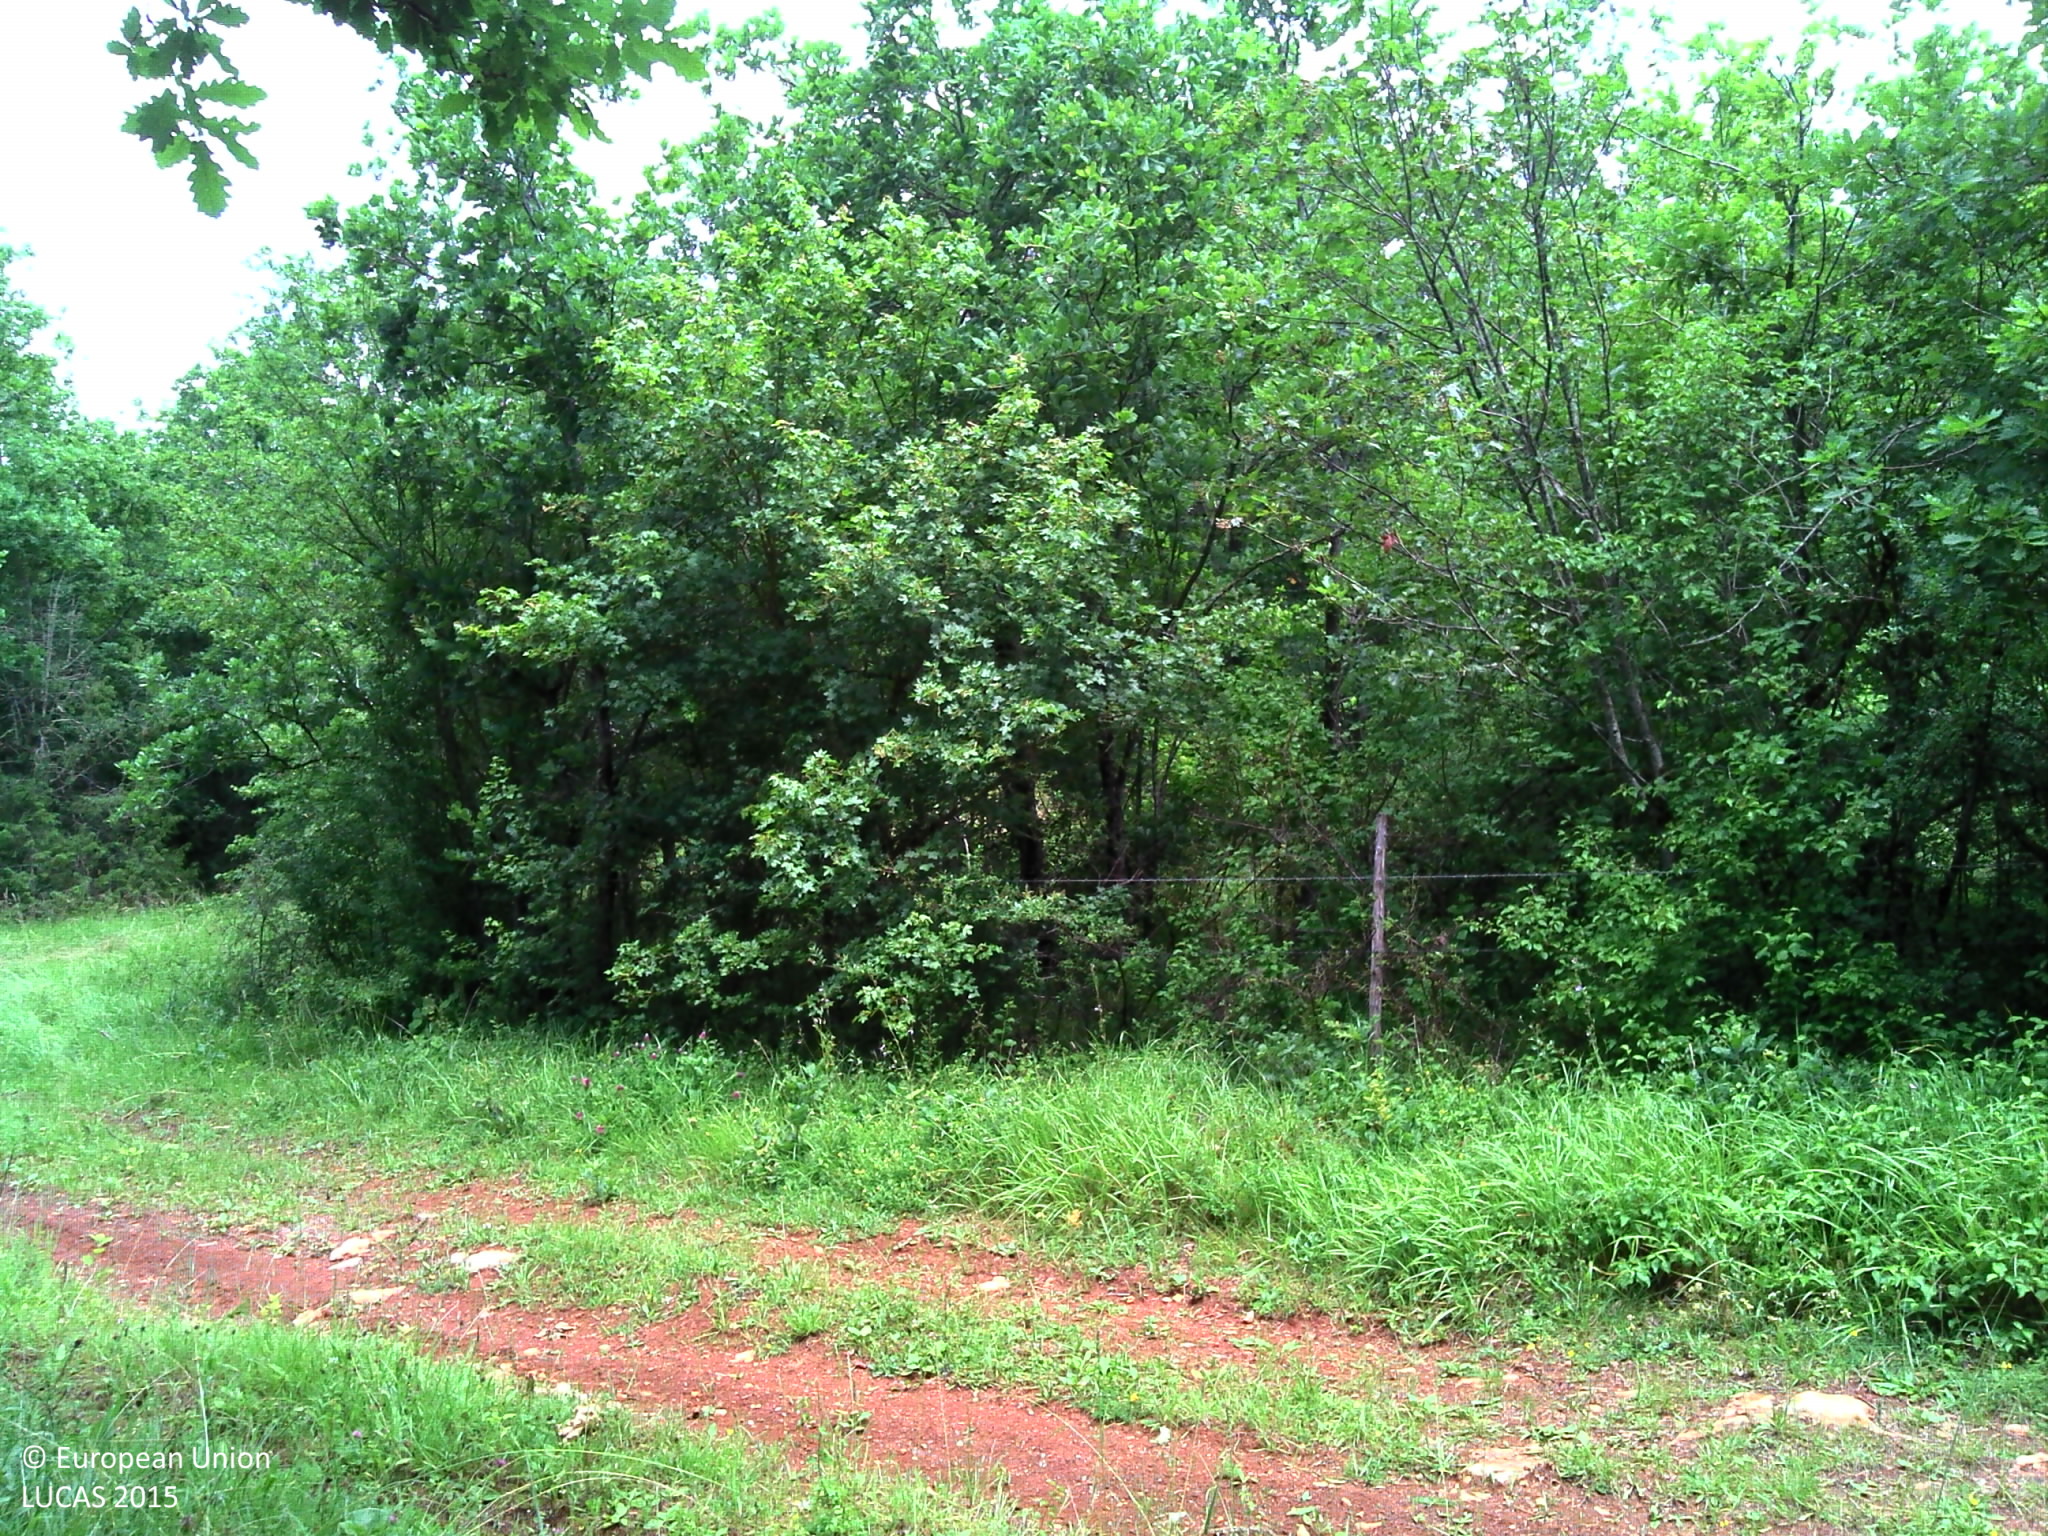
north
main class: Woodland
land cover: Broadleaved woodland
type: acidophilous oak and oak-birch forest
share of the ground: > 75 %
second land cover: Grassland without tree/shrub cover
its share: > 75 %
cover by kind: broadleaved forest trees 85 %, shrubs 10 %, herbaceous plants 5 %
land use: Forestry
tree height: > 5 m
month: June
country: FR
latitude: 44.3404
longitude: 1.8856
